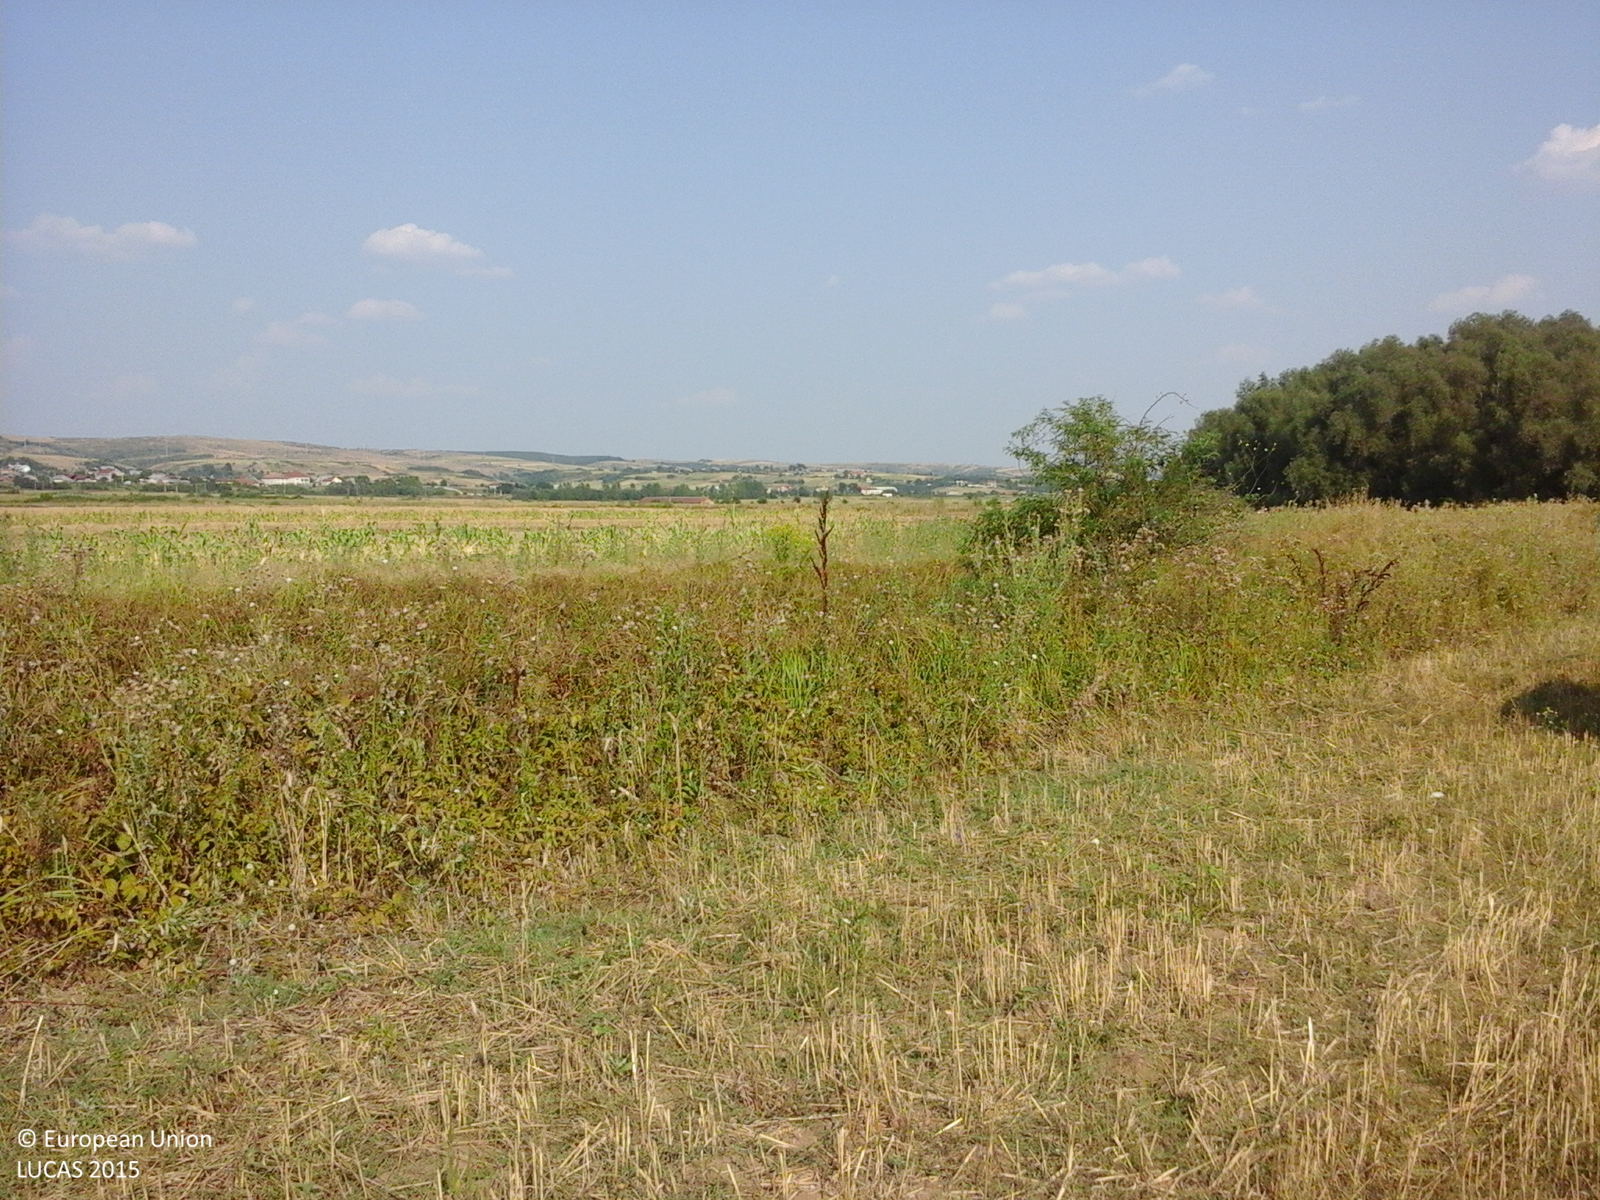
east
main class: Cropland
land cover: Common wheat
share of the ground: 50 - 75 %
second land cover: Spontaneously vegetated surfaces
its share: 25 - 50 %
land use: Agriculture (excluding fallow land and kitchen gardens)
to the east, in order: Common wheat; Spontaneously vegetated surfaces; Ditches and canals; Spontaneously vegetated surfaces; Maize; Common wheat; Maize; Spontaneously vegetated surfaces
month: August
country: RO
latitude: 44.5161
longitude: 23.5531
